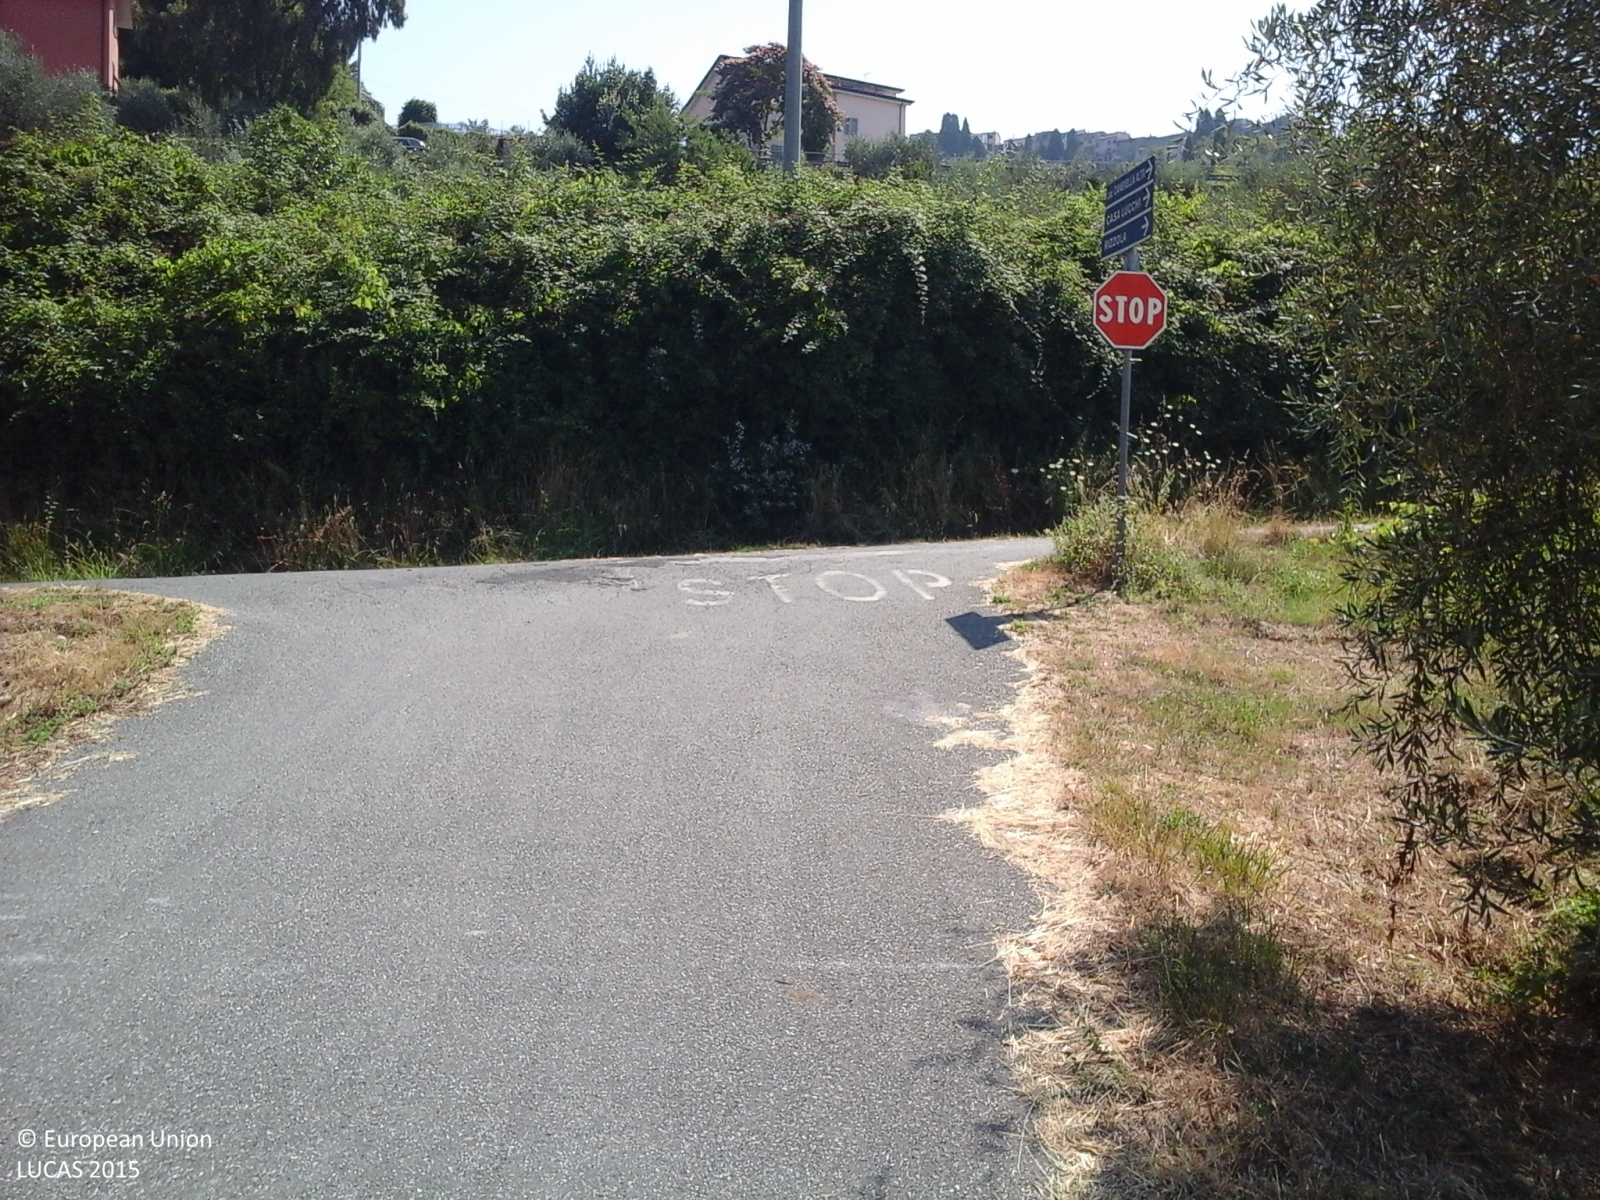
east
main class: Cropland
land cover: Olive groves
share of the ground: 25 - 50 %
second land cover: Grassland without tree/shrub cover
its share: 50 - 75 %
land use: Agriculture (excluding fallow land and kitchen gardens)
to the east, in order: Olive groves; Grassland without tree/shrub cover; Paved roads, cycling and walking lanes; Grassland without tree/shrub cover; Vineyards; Grassland with sparse tree/shrub cover; Olive groves; Vineyards; Olive groves; Paved roads, cycling and walking lanes; Grassland with sparse tree/shrub cover; Artificial constructions in urban areas; Olive groves; Electric lines; Olive groves; Paved roads, cycling and walking lanes; Grassland with sparse tree/shrub cover; Broadleaved woodland
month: July
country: IT
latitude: 44.1882
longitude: 9.8877
